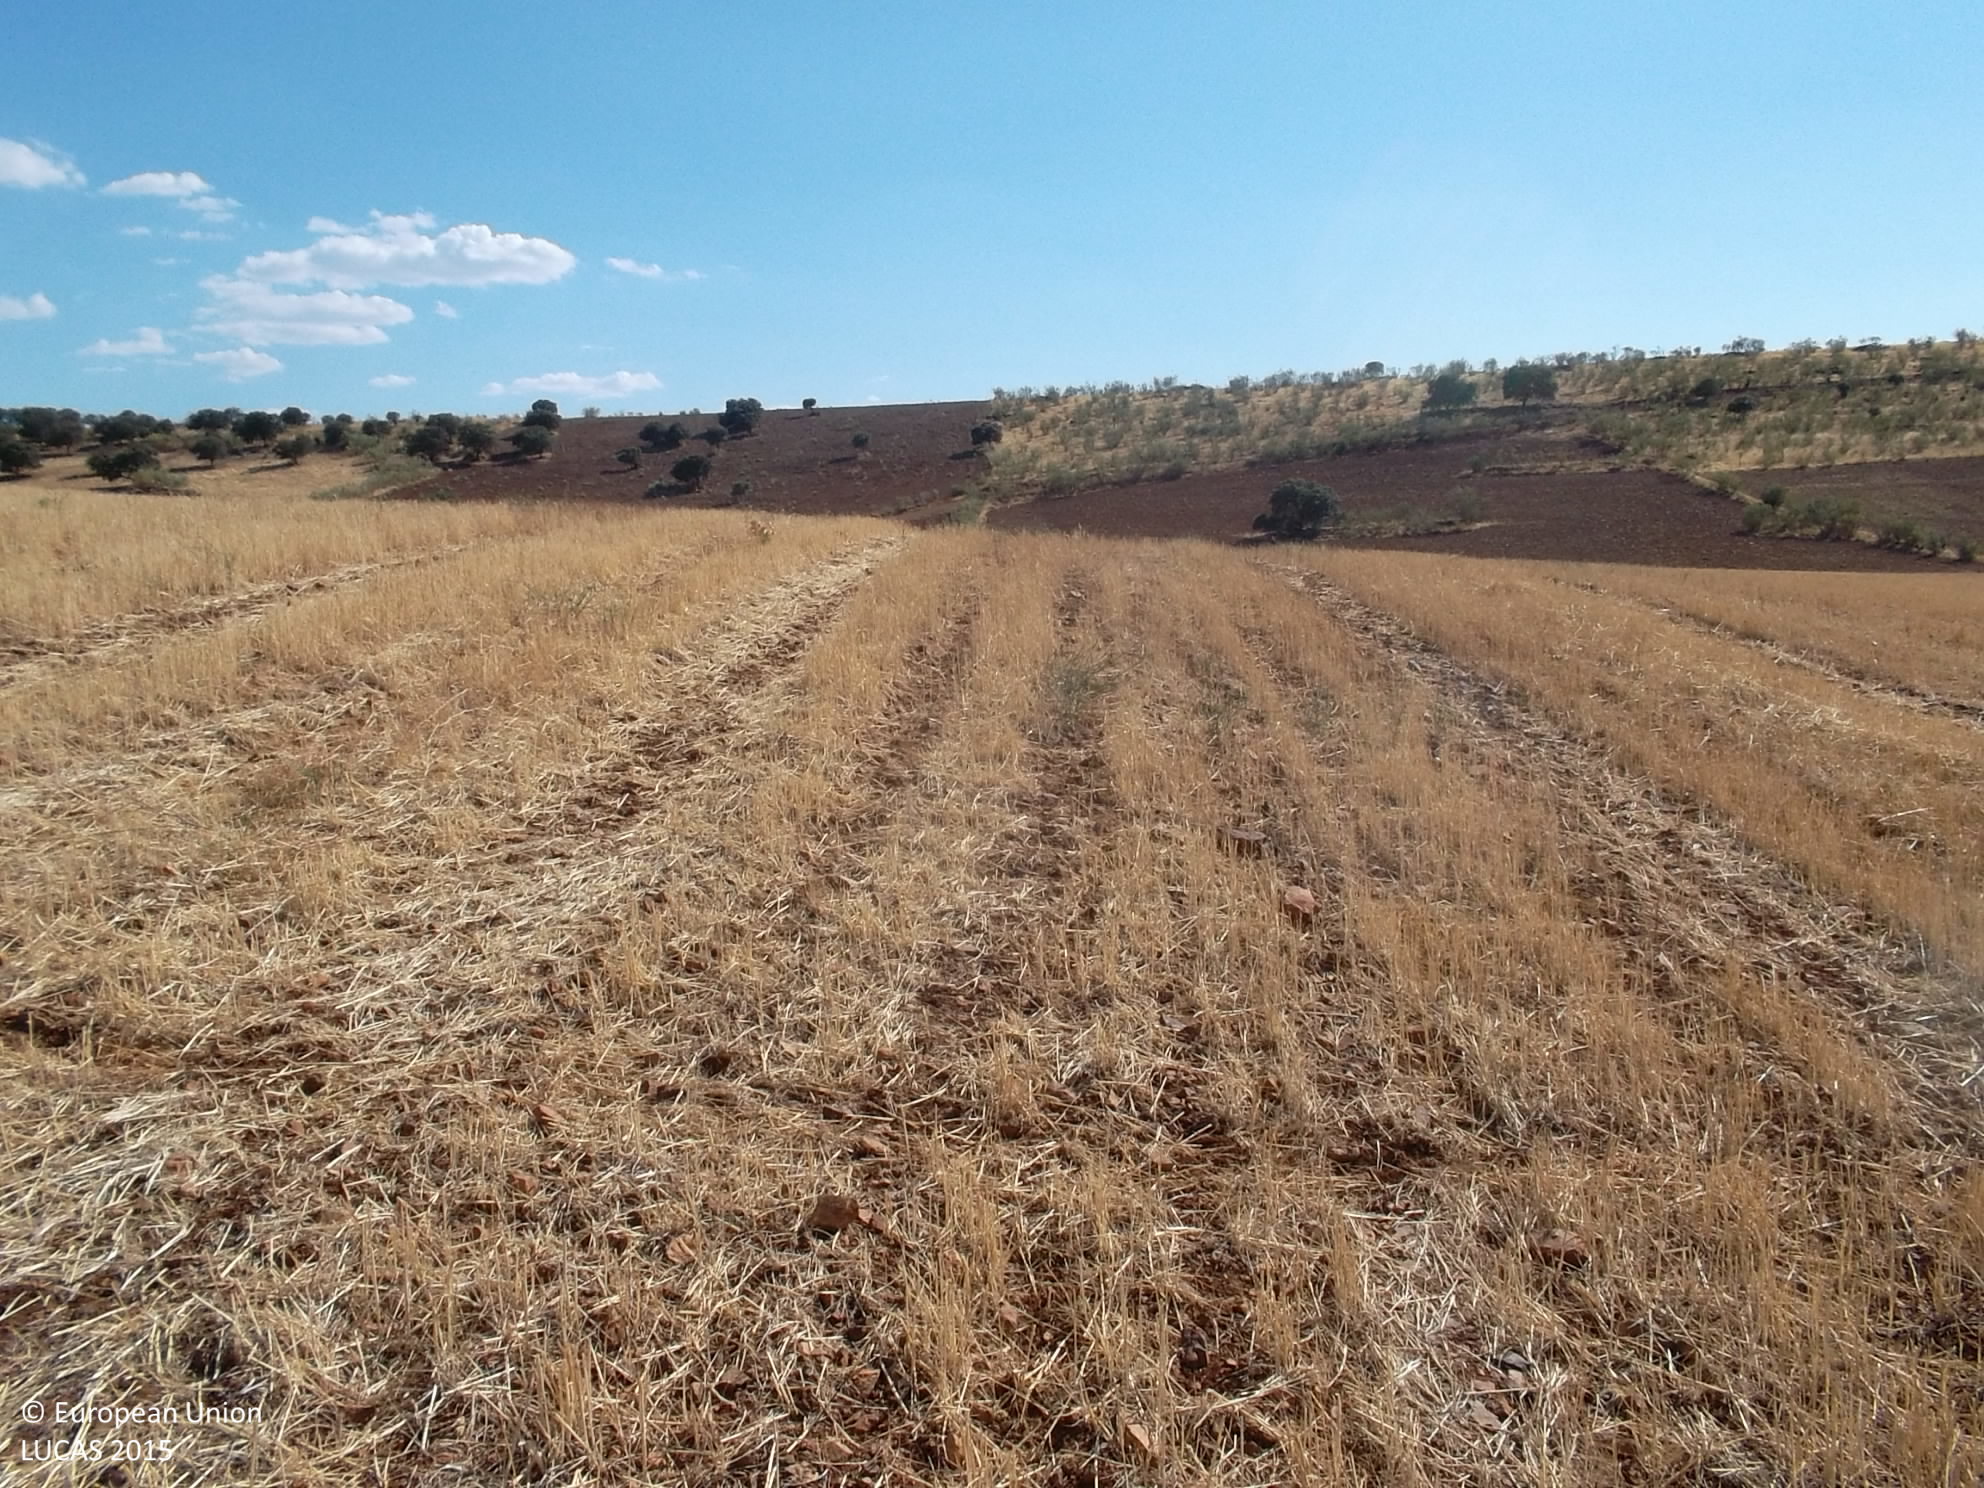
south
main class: Cropland
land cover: Durum wheat
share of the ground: < 10 %
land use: Agriculture (excluding fallow land and kitchen gardens)
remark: Harvested field
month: July
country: ES
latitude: 38.5766
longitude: -5.7785
